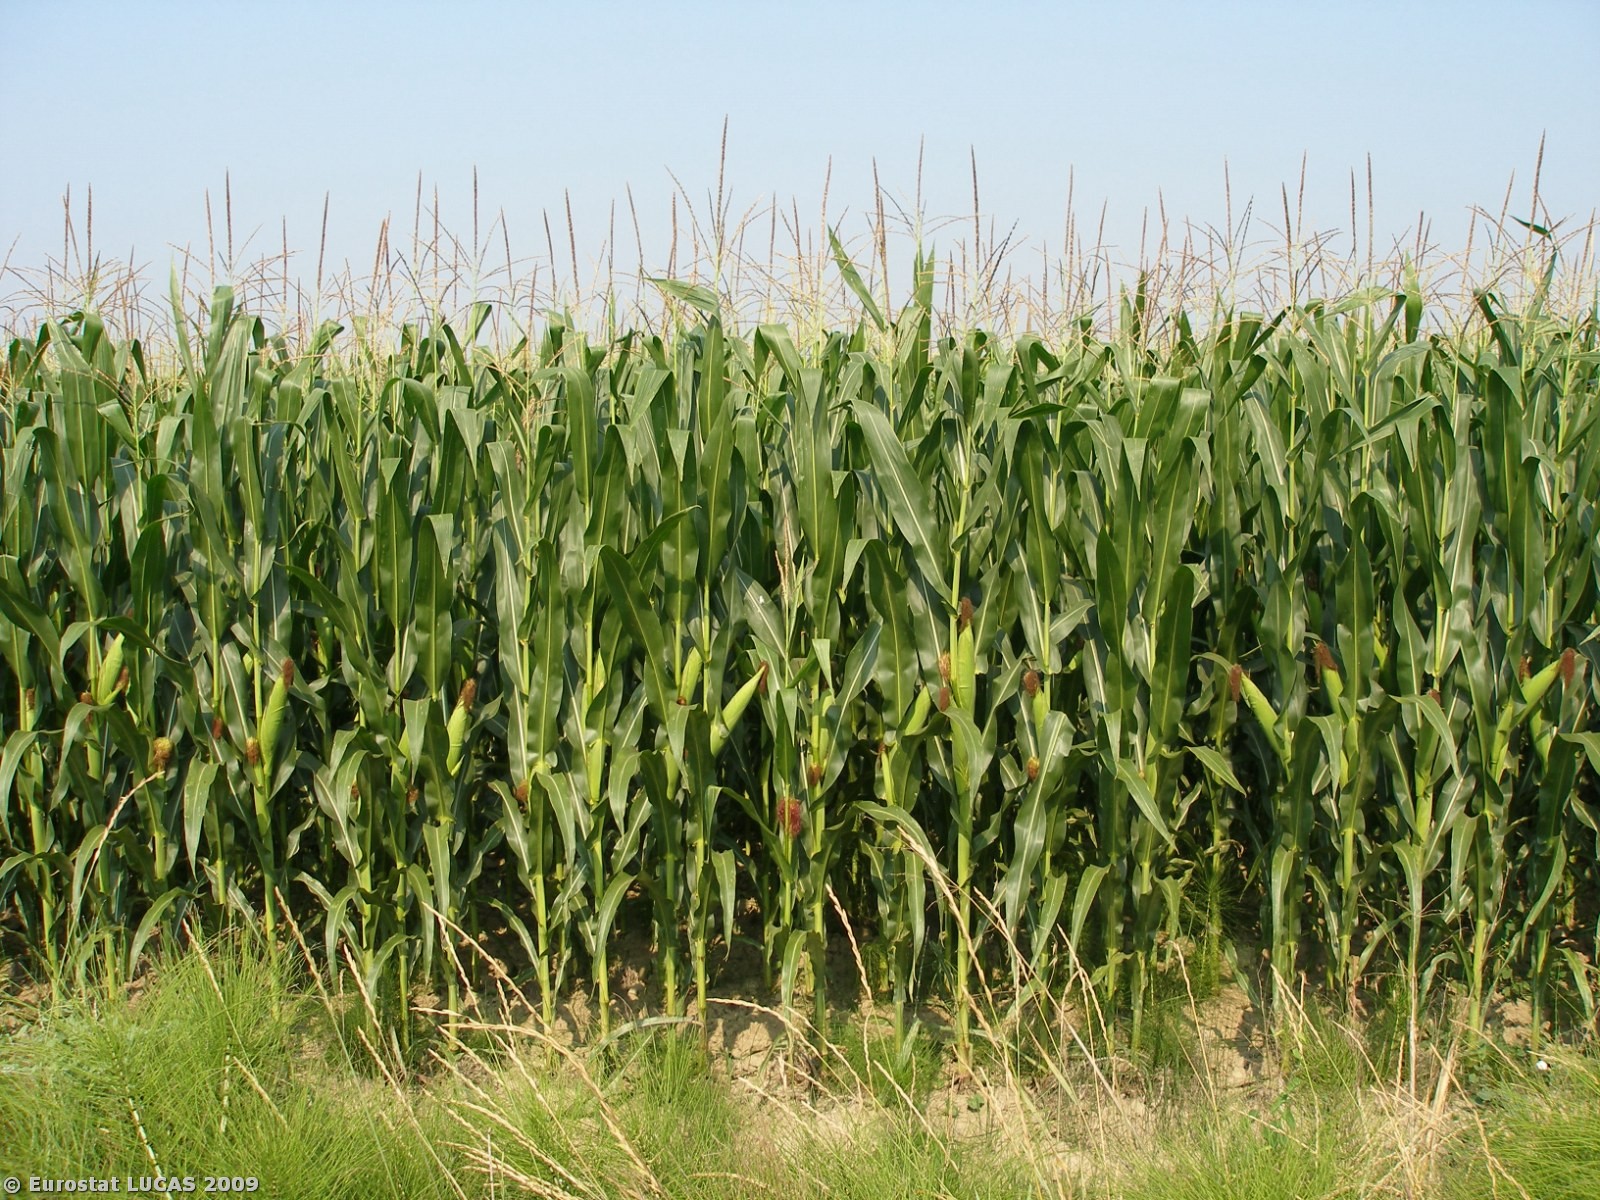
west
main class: Cropland
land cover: Maize
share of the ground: > 75 %
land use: Agriculture (excluding fallow land and kitchen gardens)
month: July
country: IT
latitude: 45.0034
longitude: 11.7348
